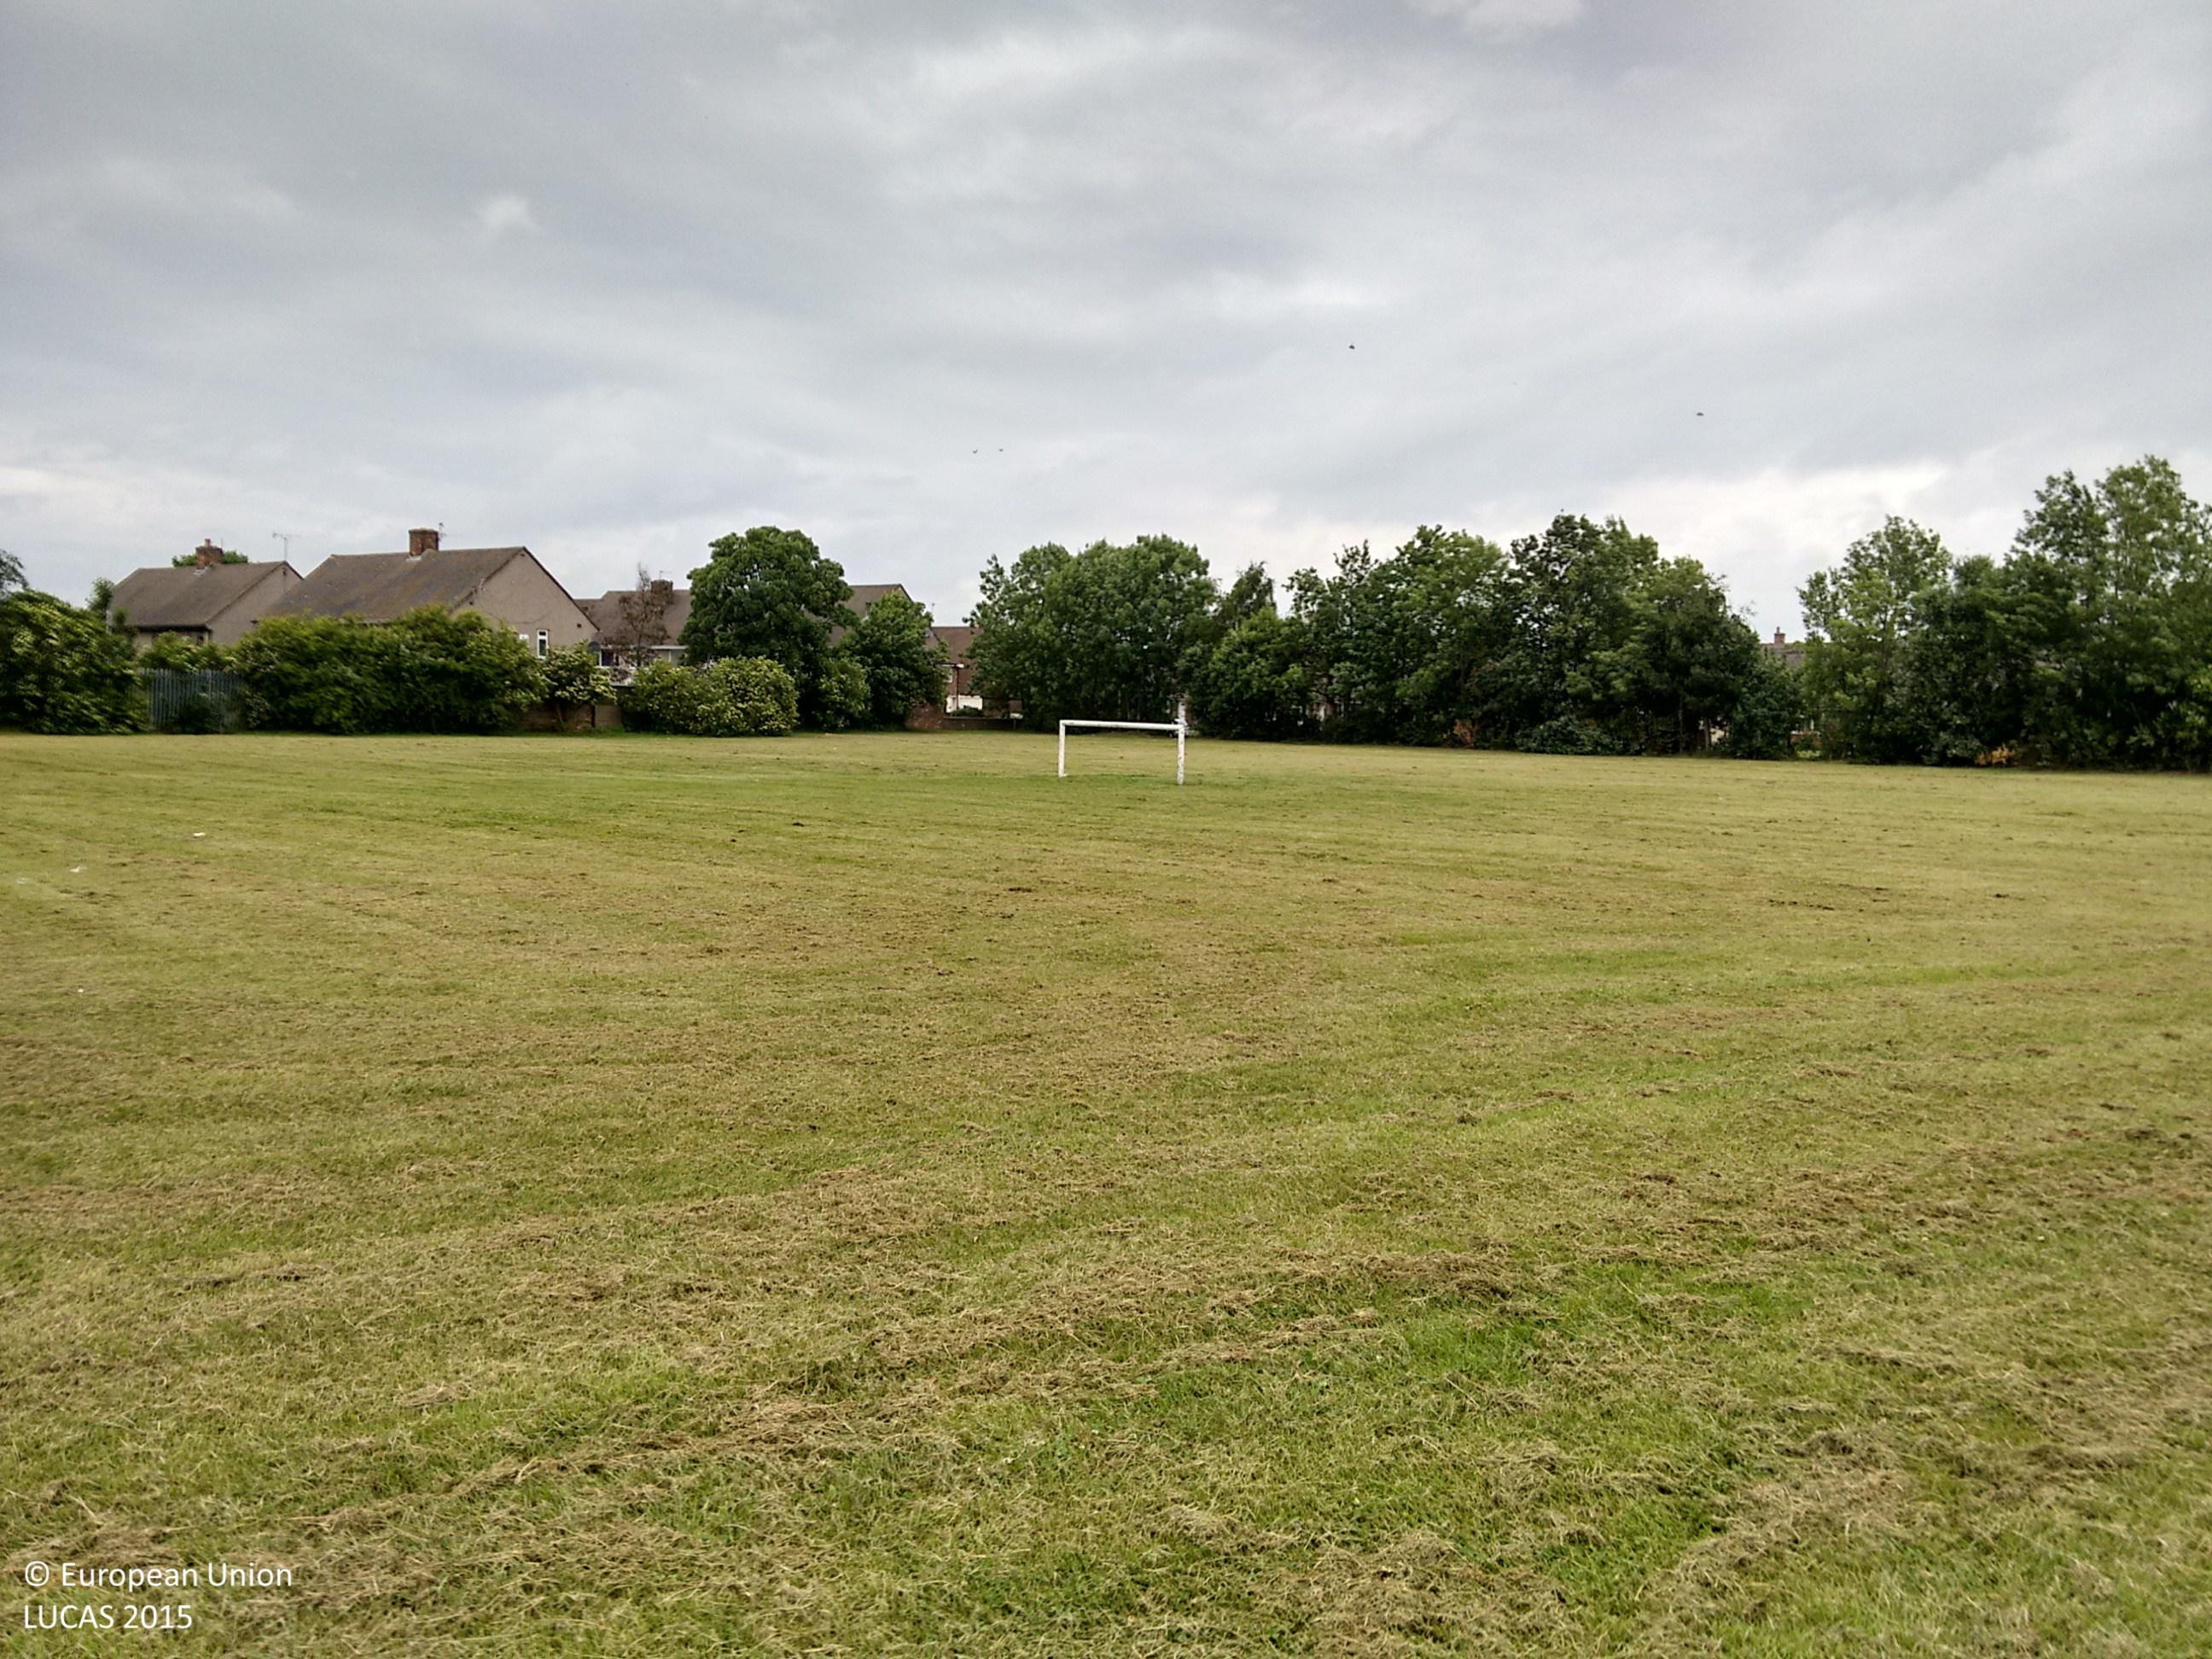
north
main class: Grassland
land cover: Grassland without tree/shrub cover
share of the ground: > 75 %
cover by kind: herbaceous plants 100 %
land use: Amenities, museums, leisure
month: June
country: GB
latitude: 53.4966
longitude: -3.0234
